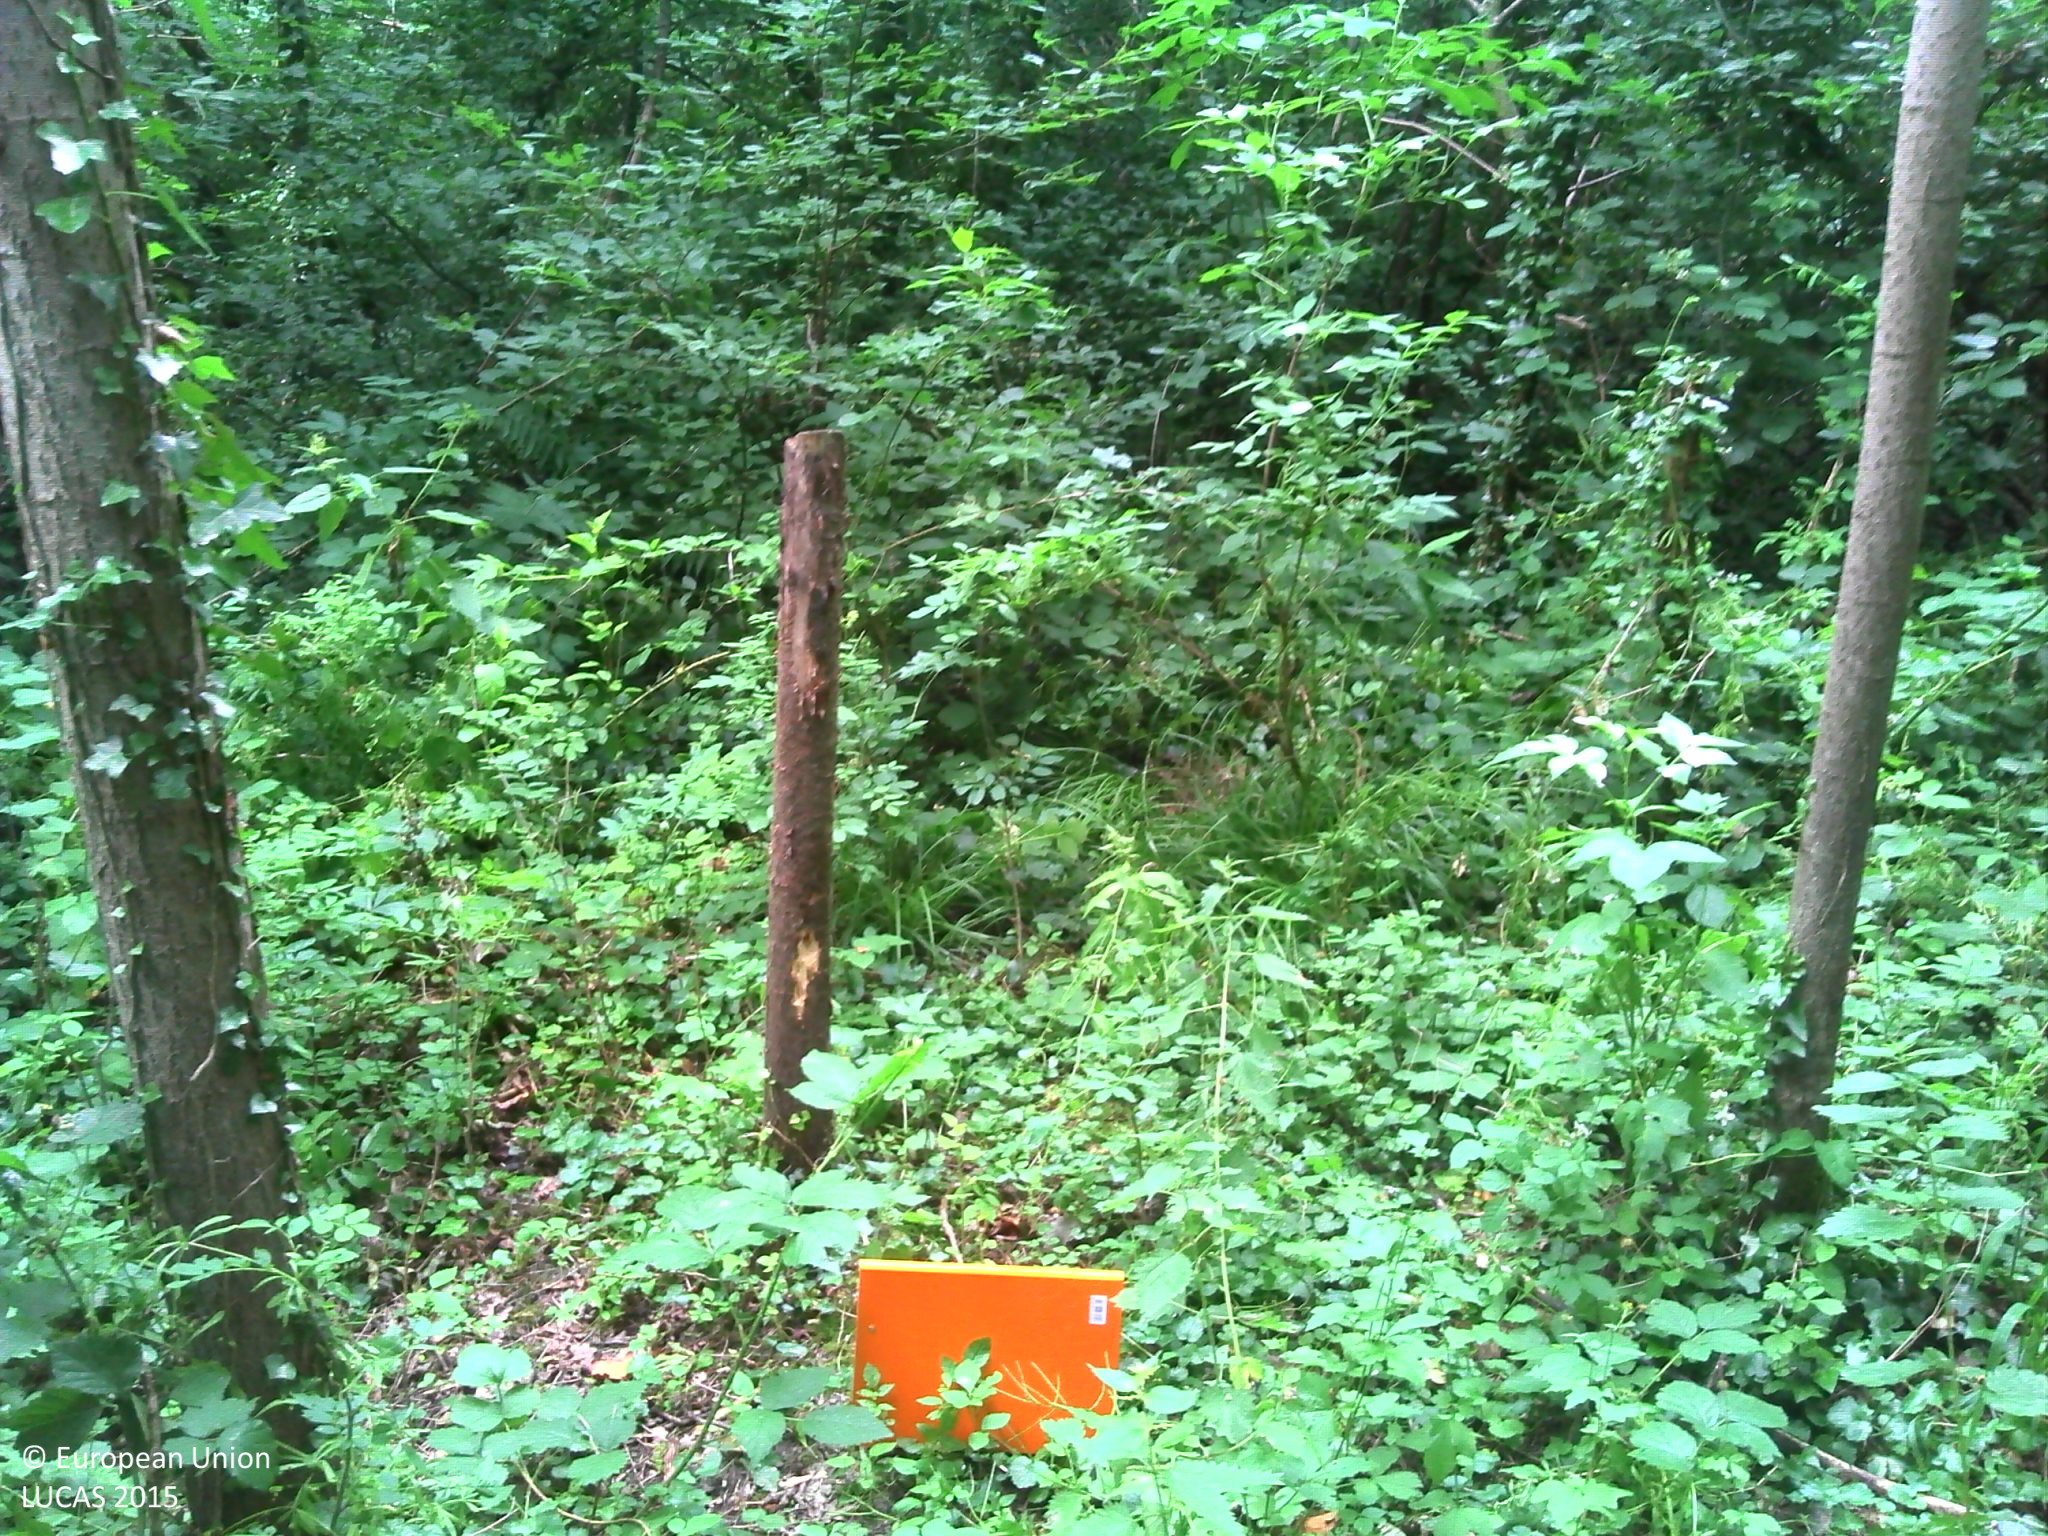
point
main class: Woodland
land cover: Broadleaved woodland
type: acidophilous oak and oak-birch forest
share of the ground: > 75 %
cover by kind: broadleaved forest trees 85 %, shrubs 10 %, herbaceous plants 5 %
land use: Forestry
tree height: > 5 m
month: June
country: FR
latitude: 49.3755
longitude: 3.6442
